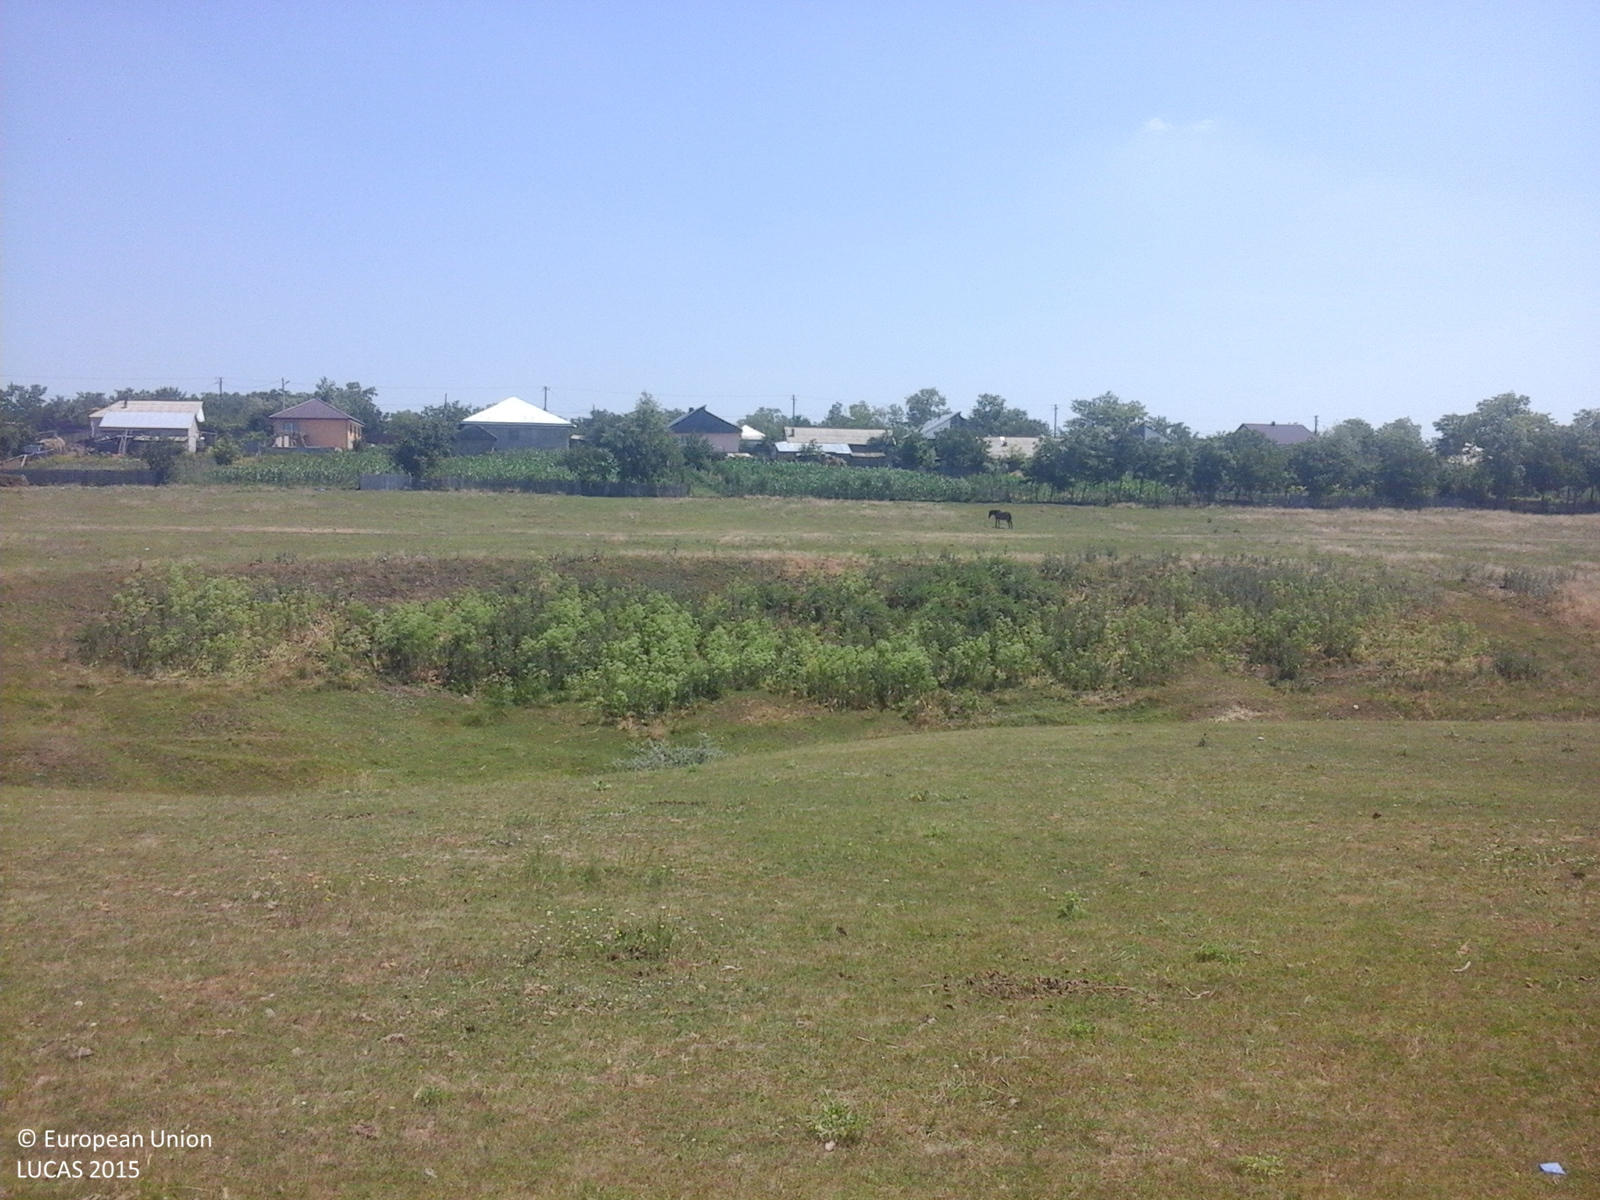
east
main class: Grassland
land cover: Grassland without tree/shrub cover
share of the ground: > 75 %
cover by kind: herbaceous plants 100 %
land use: Agriculture (excluding fallow land and kitchen gardens)
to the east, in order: Grassland without tree/shrub cover; Ditches and canals; Spontaneously vegetated surfaces; Shruby margins; Grassland without tree/shrub cover; Fences; Maize; Artificial constructions in urban areas
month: June
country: RO
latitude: 47.2816
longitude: 27.3109
